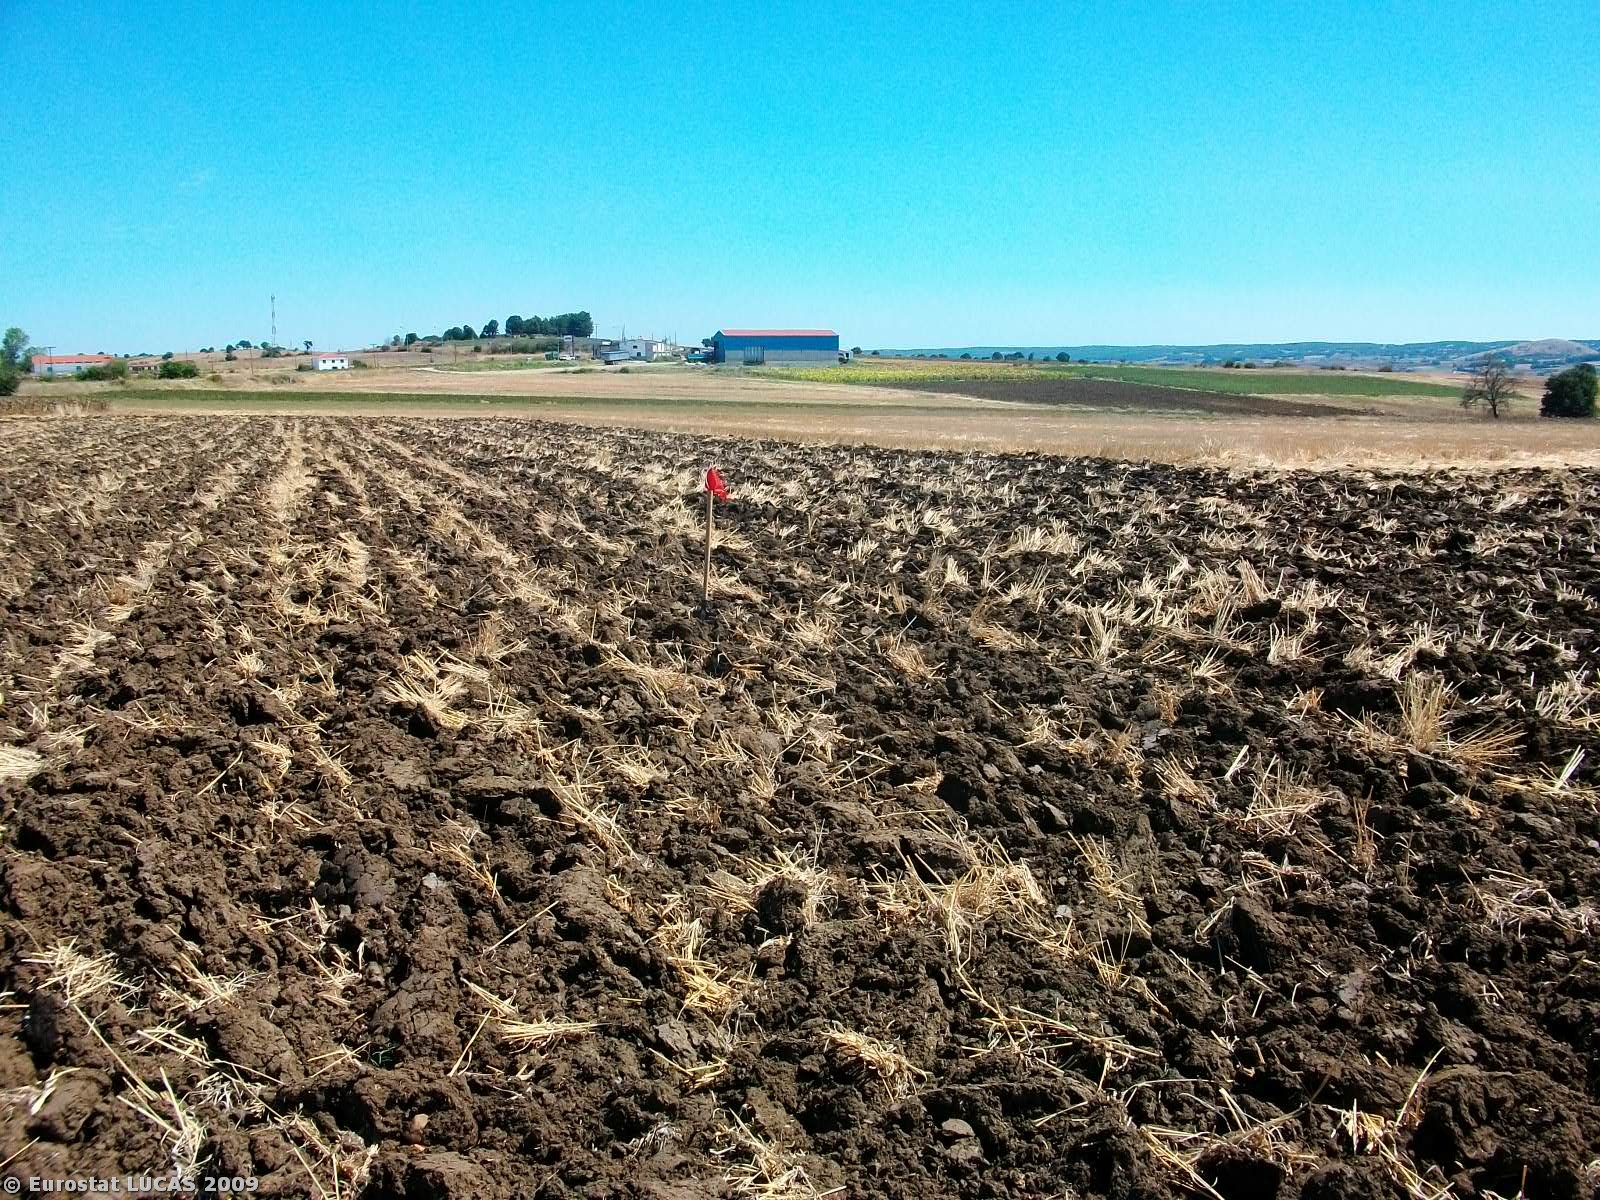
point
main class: Cropland
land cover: Common wheat
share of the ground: < 10 %
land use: Agriculture (excluding fallow land and kitchen gardens)
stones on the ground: < 10 %
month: August
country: GR
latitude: 41.3924
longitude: 26.3266
